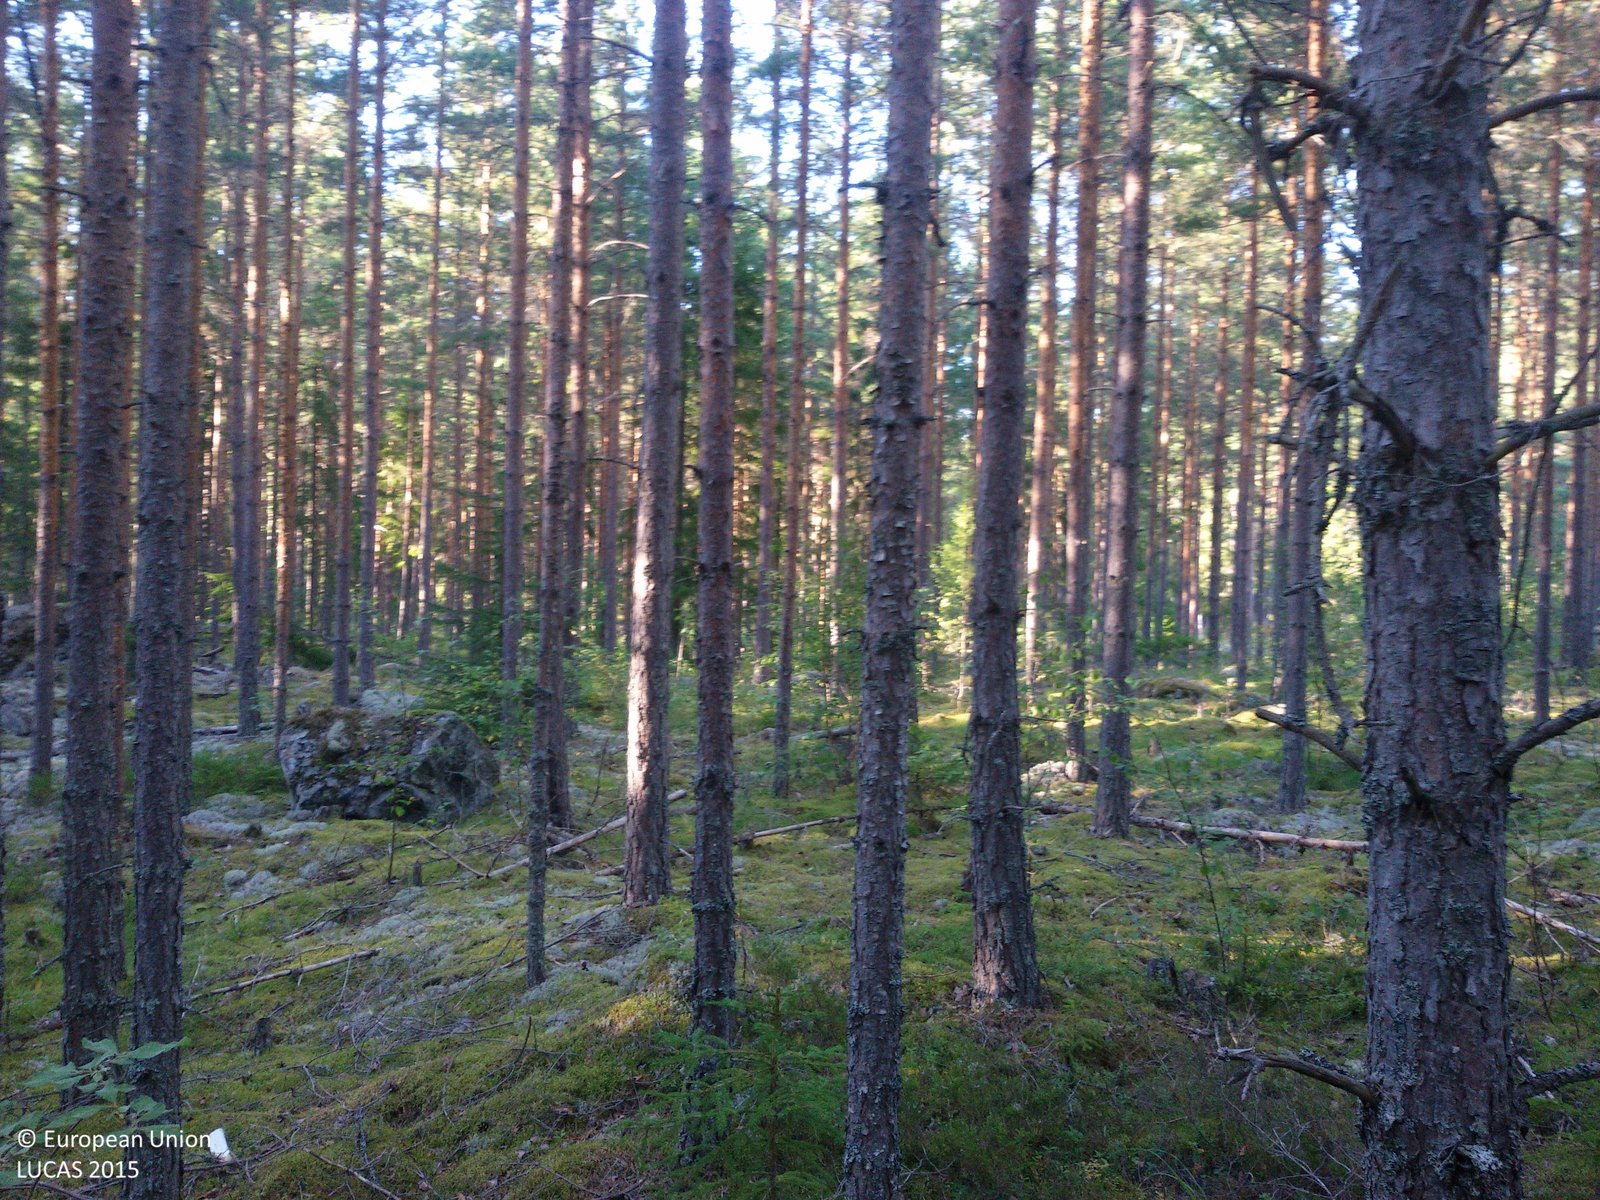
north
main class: Woodland
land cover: Pine dominated coniferous woodland
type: boreal forest
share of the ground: > 75 %
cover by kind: coniferous forest trees 80 %, lichens and mosses 15 %, shrubs 5 %
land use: Forestry
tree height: > 5 m
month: August
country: SE
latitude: 60.6893
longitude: 15.9020
